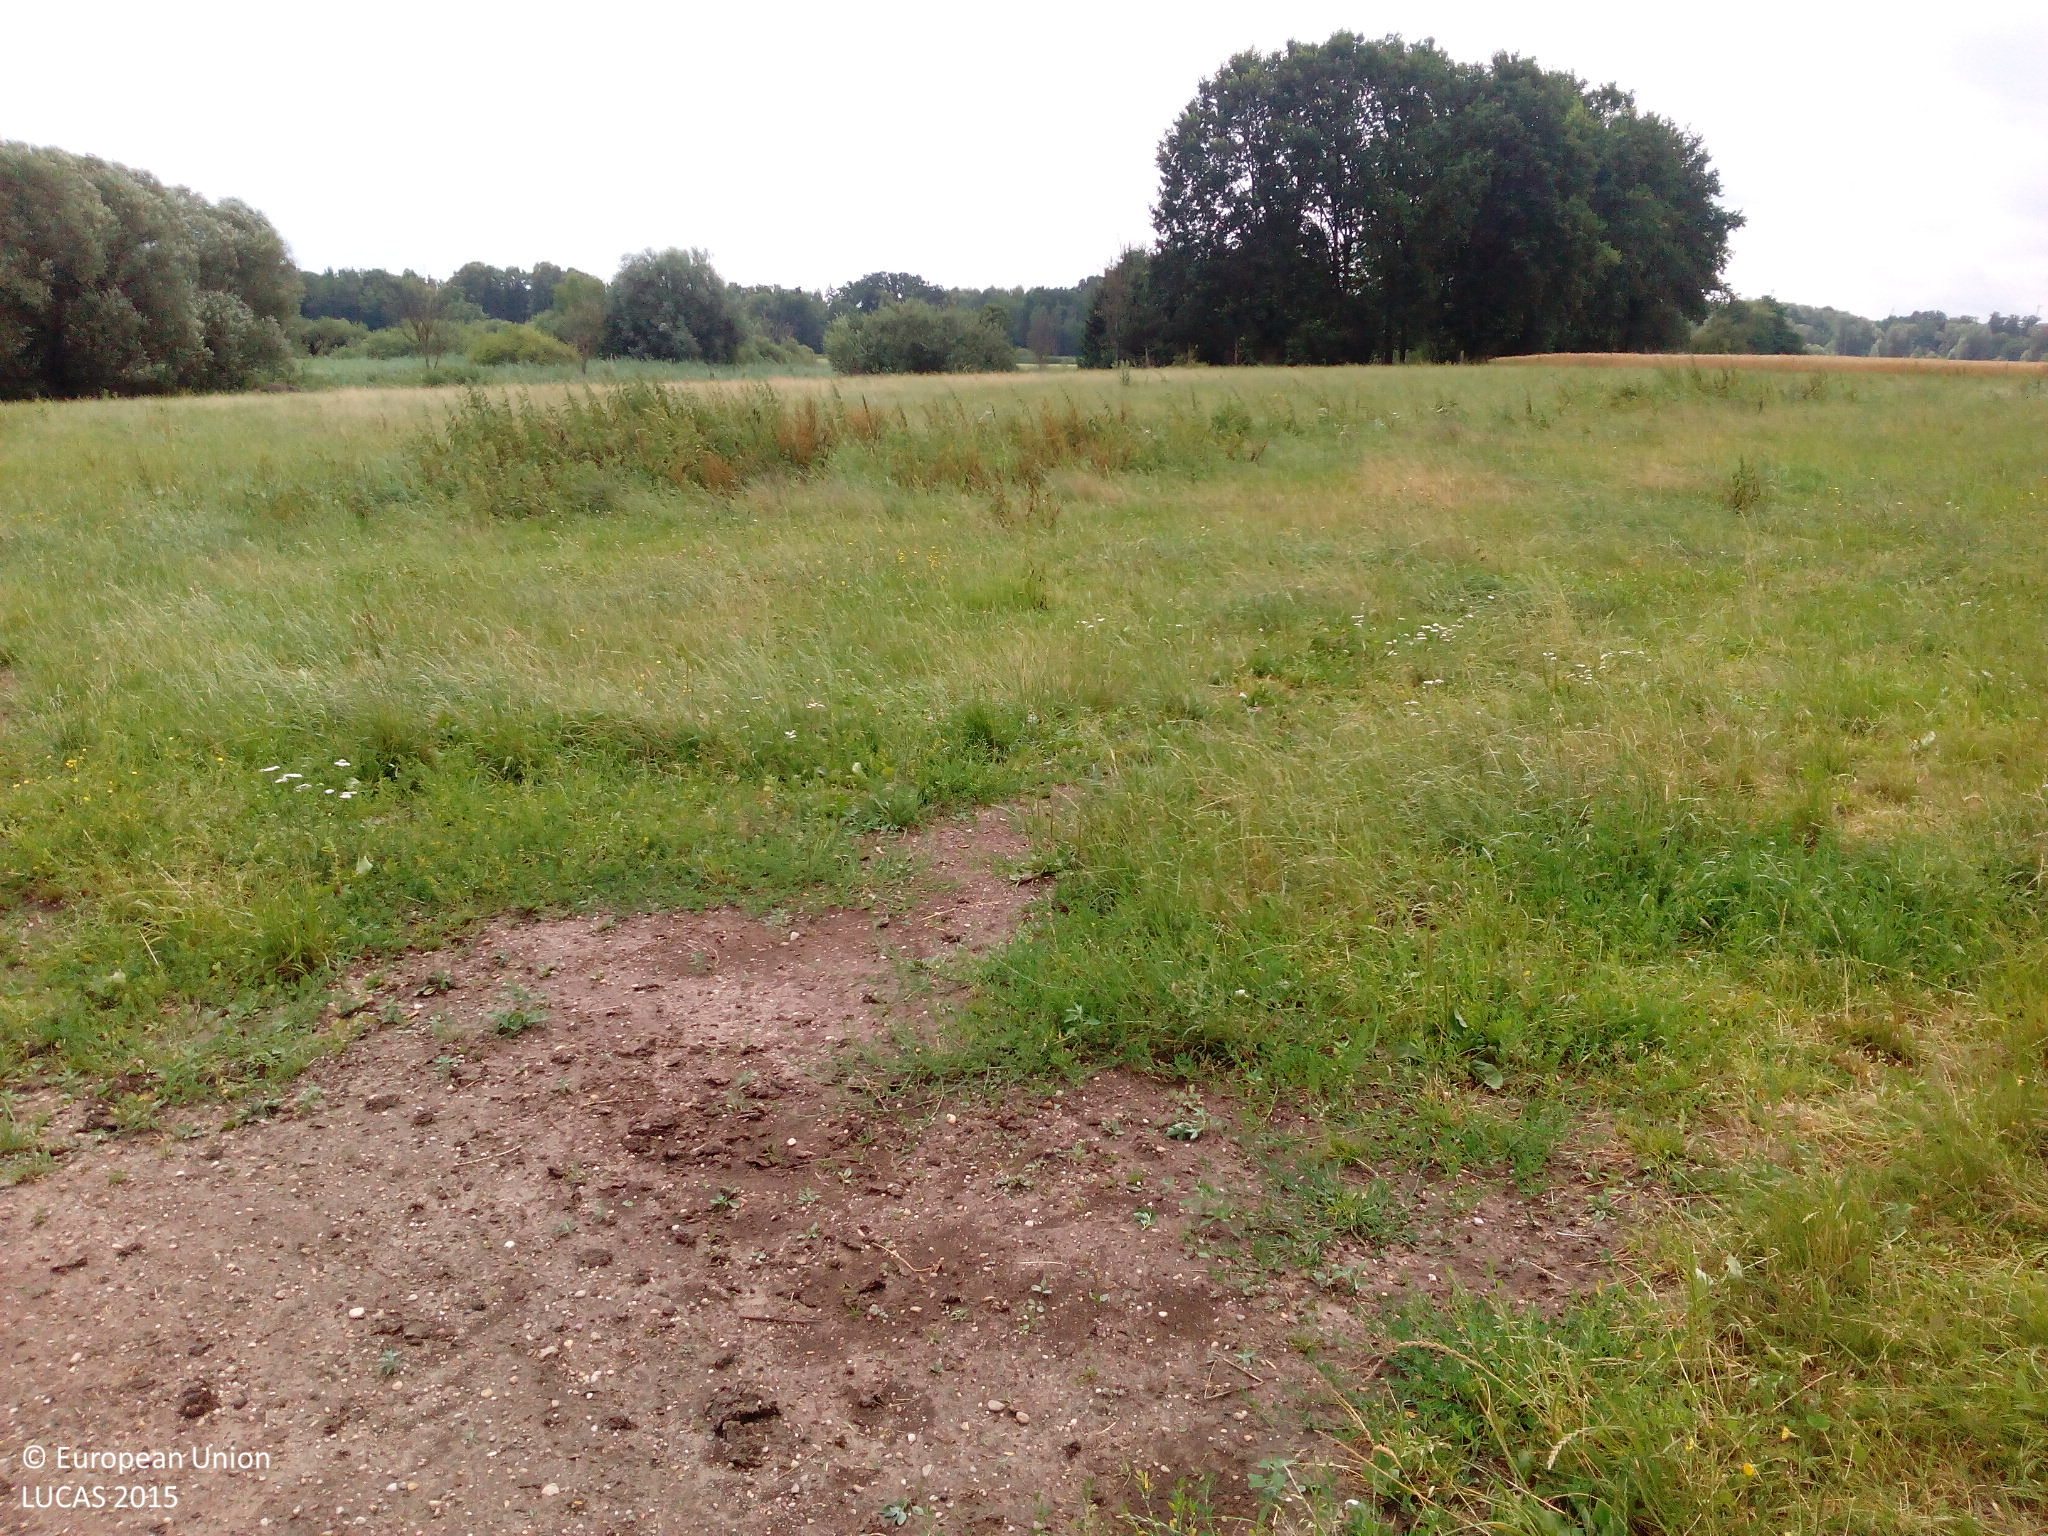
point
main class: Grassland
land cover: Grassland without tree/shrub cover
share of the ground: > 75 %
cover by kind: herbaceous plants 80 %, unconsolidated bare surface 15 %, lichens and mosses 5 %
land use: Agriculture (excluding fallow land and kitchen gardens)
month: July
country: DE
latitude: 48.6103
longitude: 11.4235
